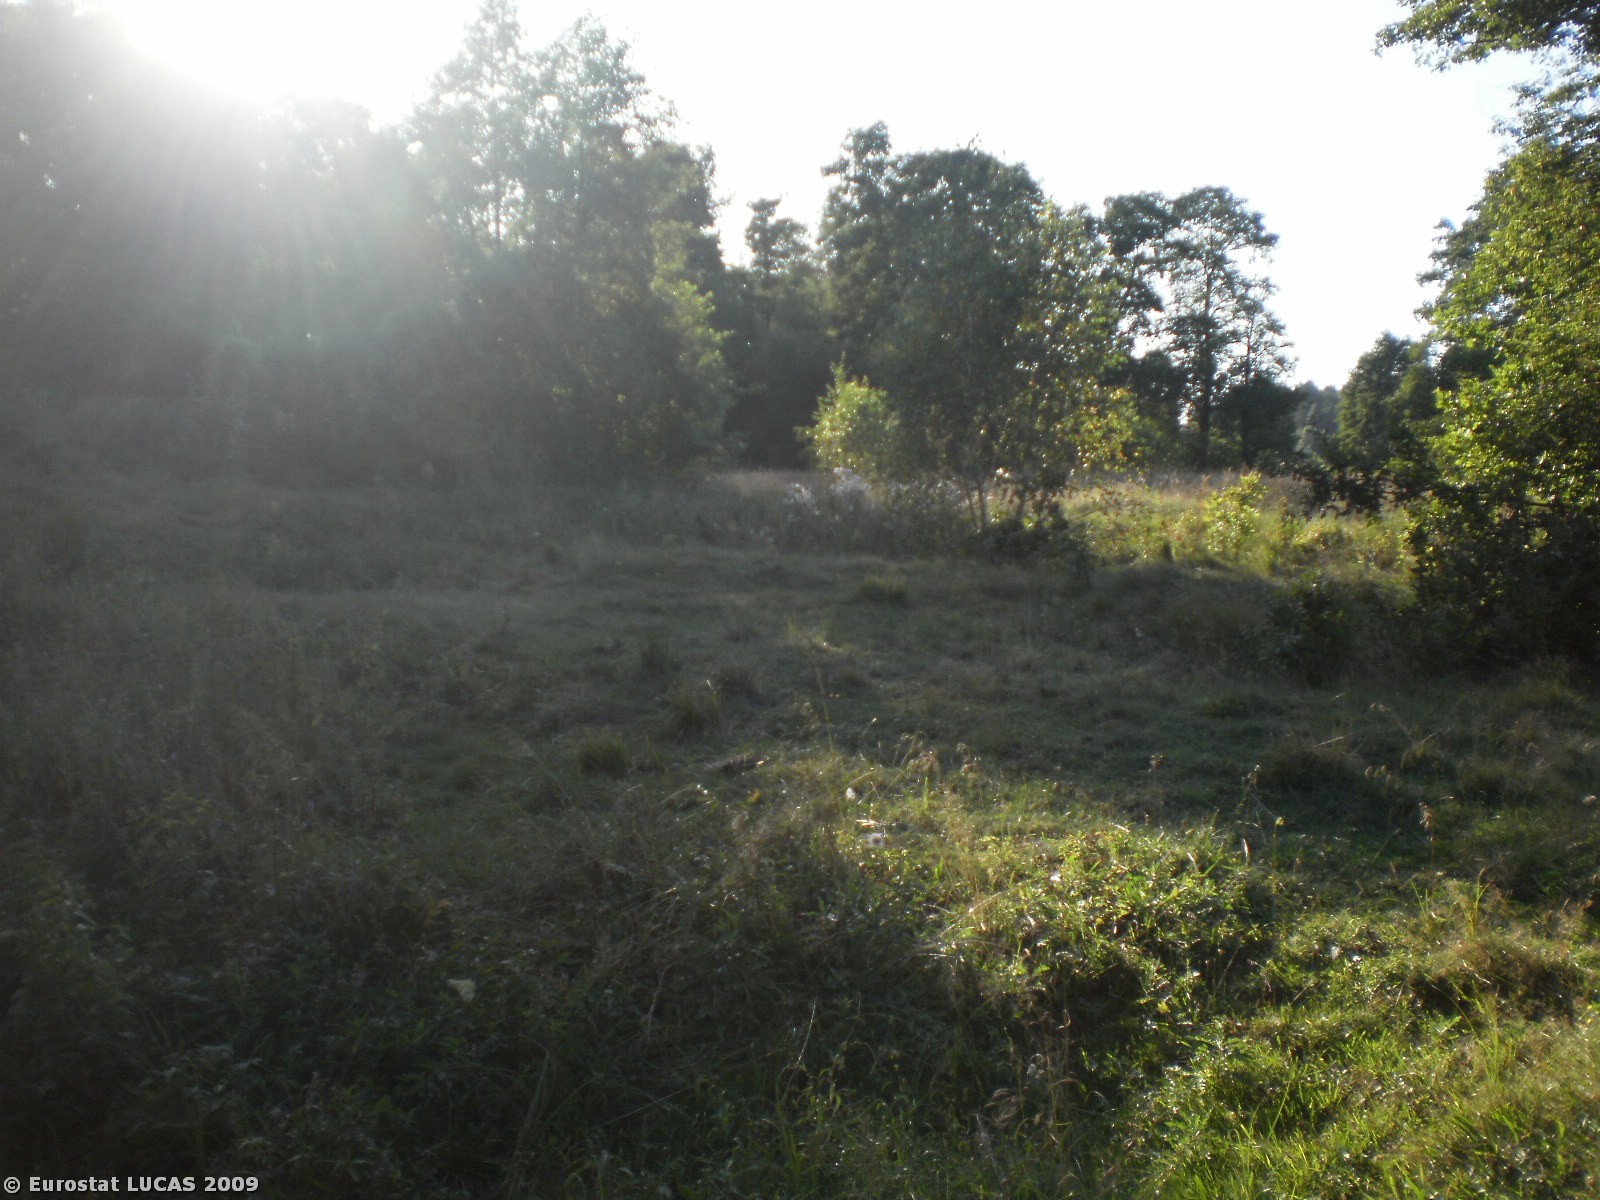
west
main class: Grassland
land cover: Grassland with sparse tree/shrub cover
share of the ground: > 75 %
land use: Agriculture (excluding fallow land and kitchen gardens)
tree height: < 5 m
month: August
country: PL
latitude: 53.2509
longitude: 21.8812
